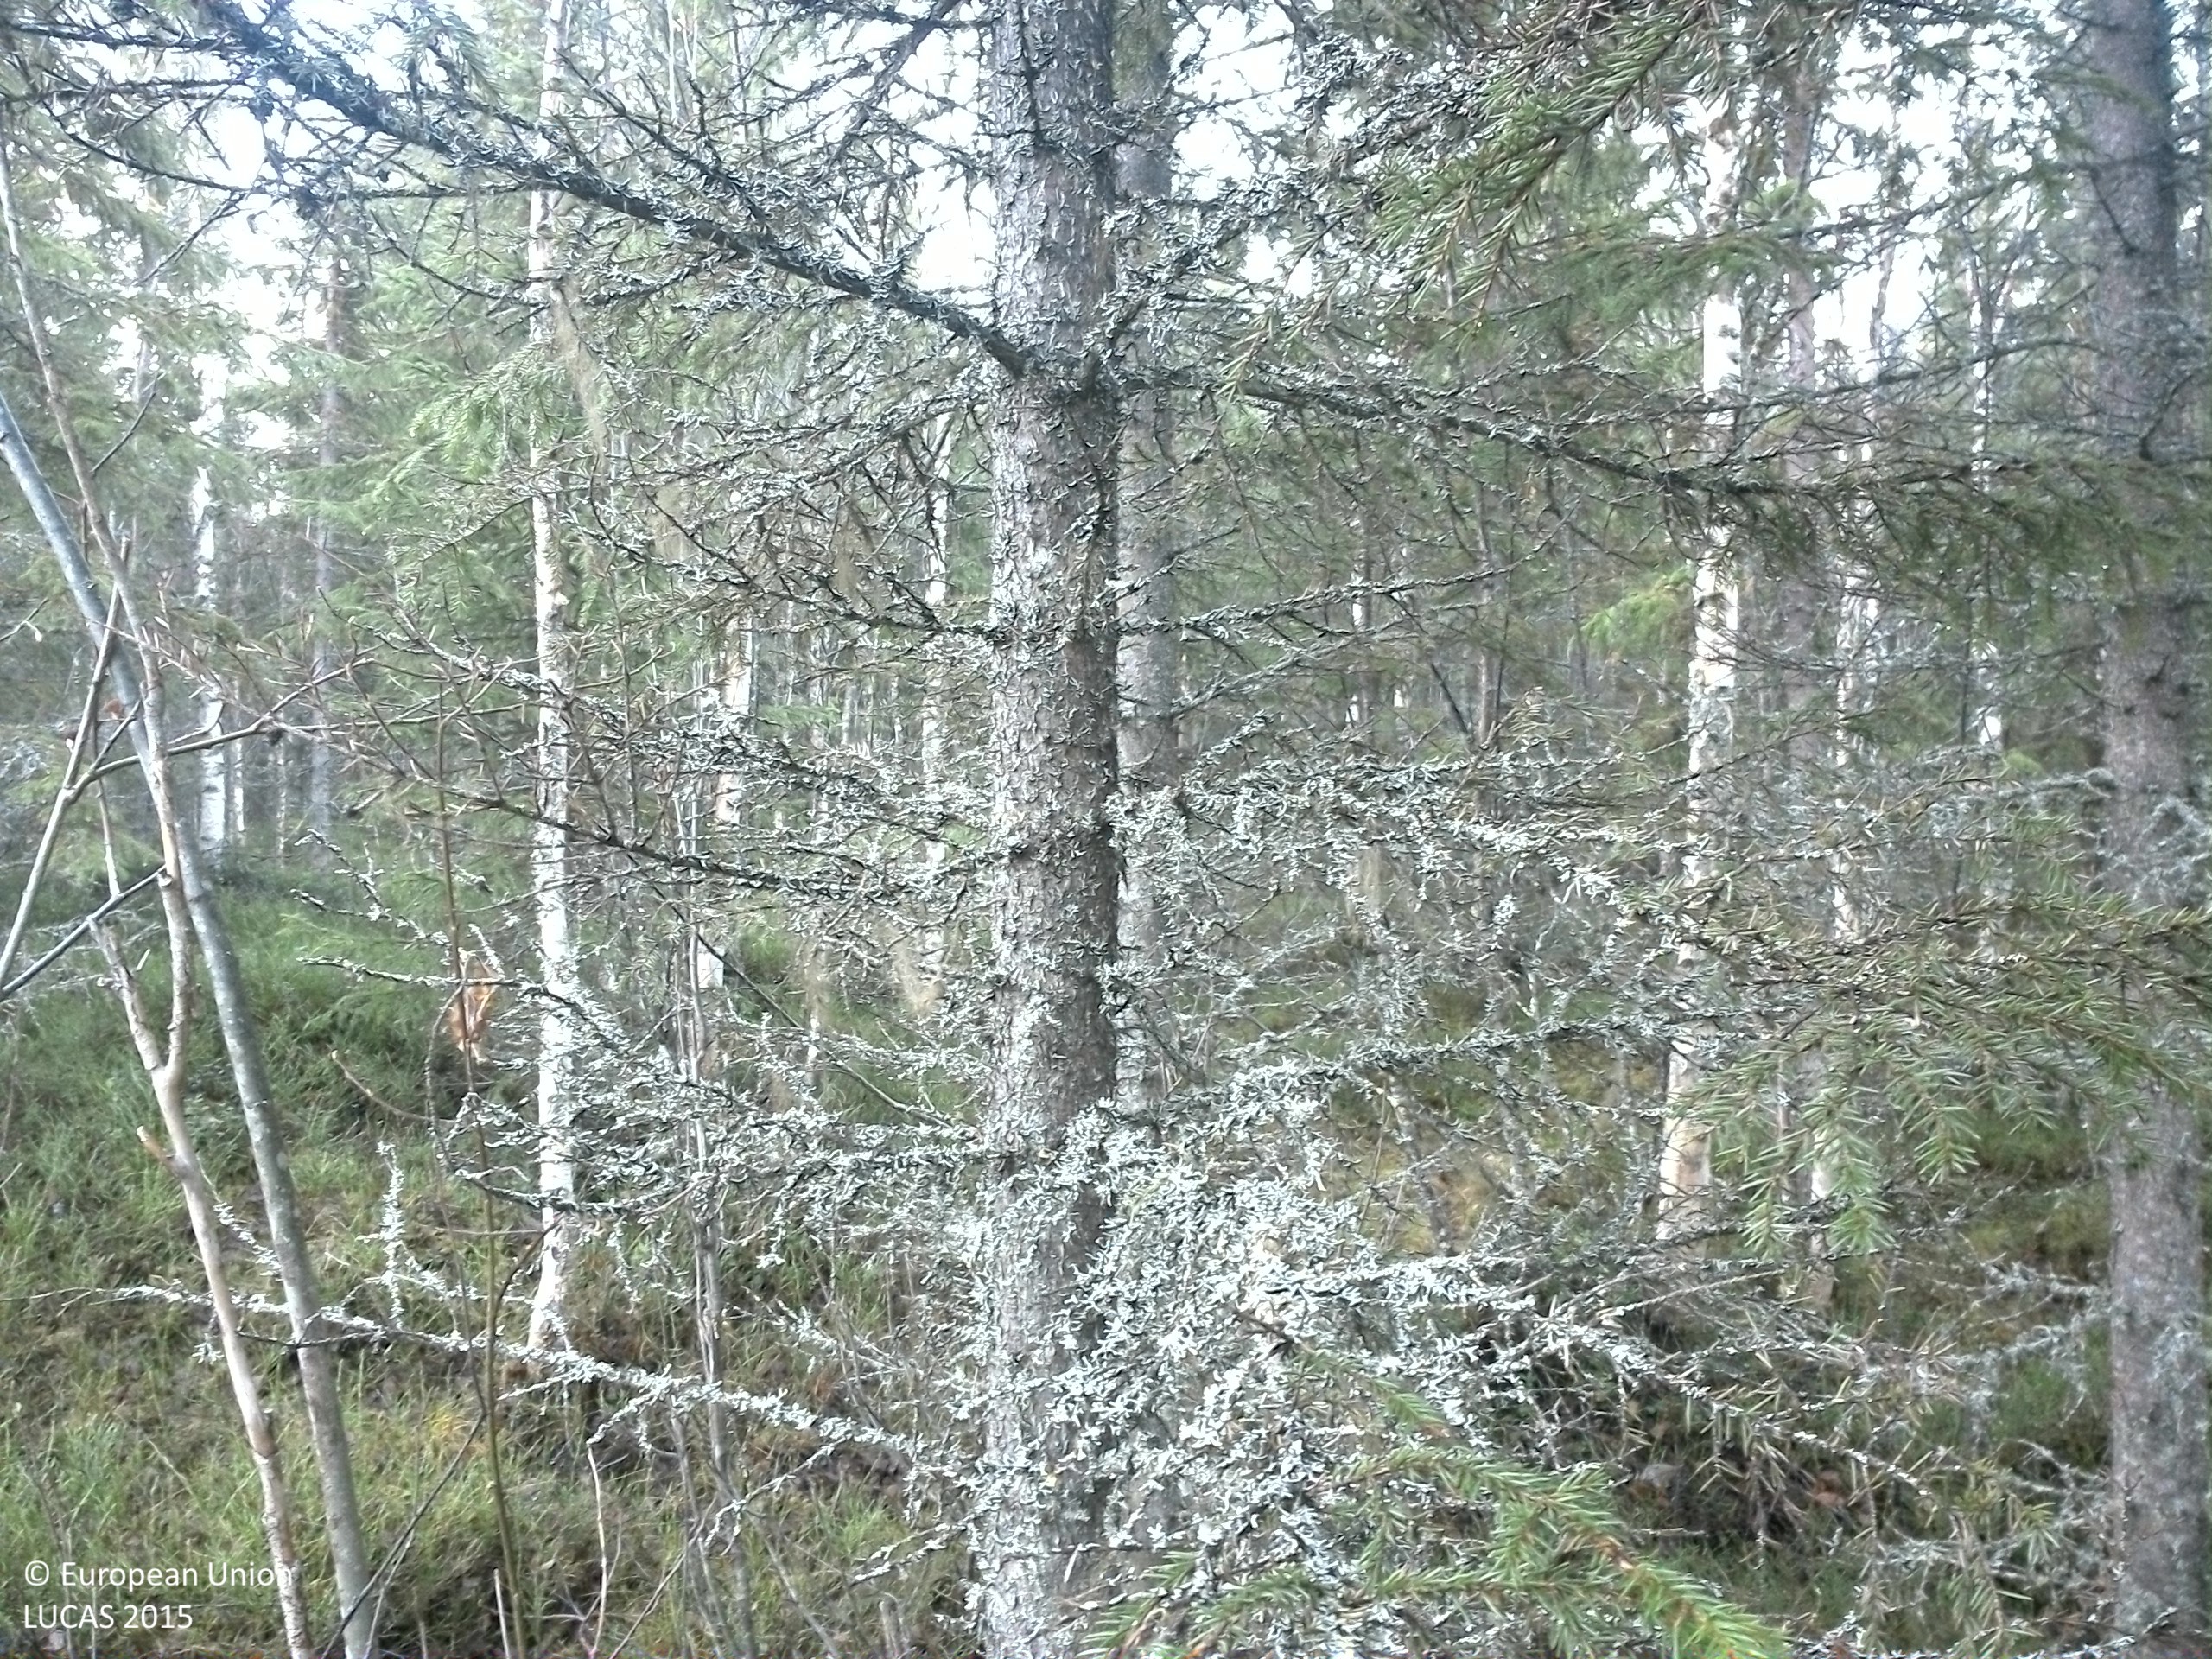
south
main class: Woodland
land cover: Spruce dominated mixed woodland
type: boreal forest
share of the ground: 50 - 75 %
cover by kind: coniferous forest trees 45 %, broadleaved forest trees 20 %, shrubs 20 %, lichens and mosses 15 %
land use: Forestry
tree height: > 5 m
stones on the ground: > 50 %
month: October
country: SE
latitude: 64.0292
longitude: 15.5599
